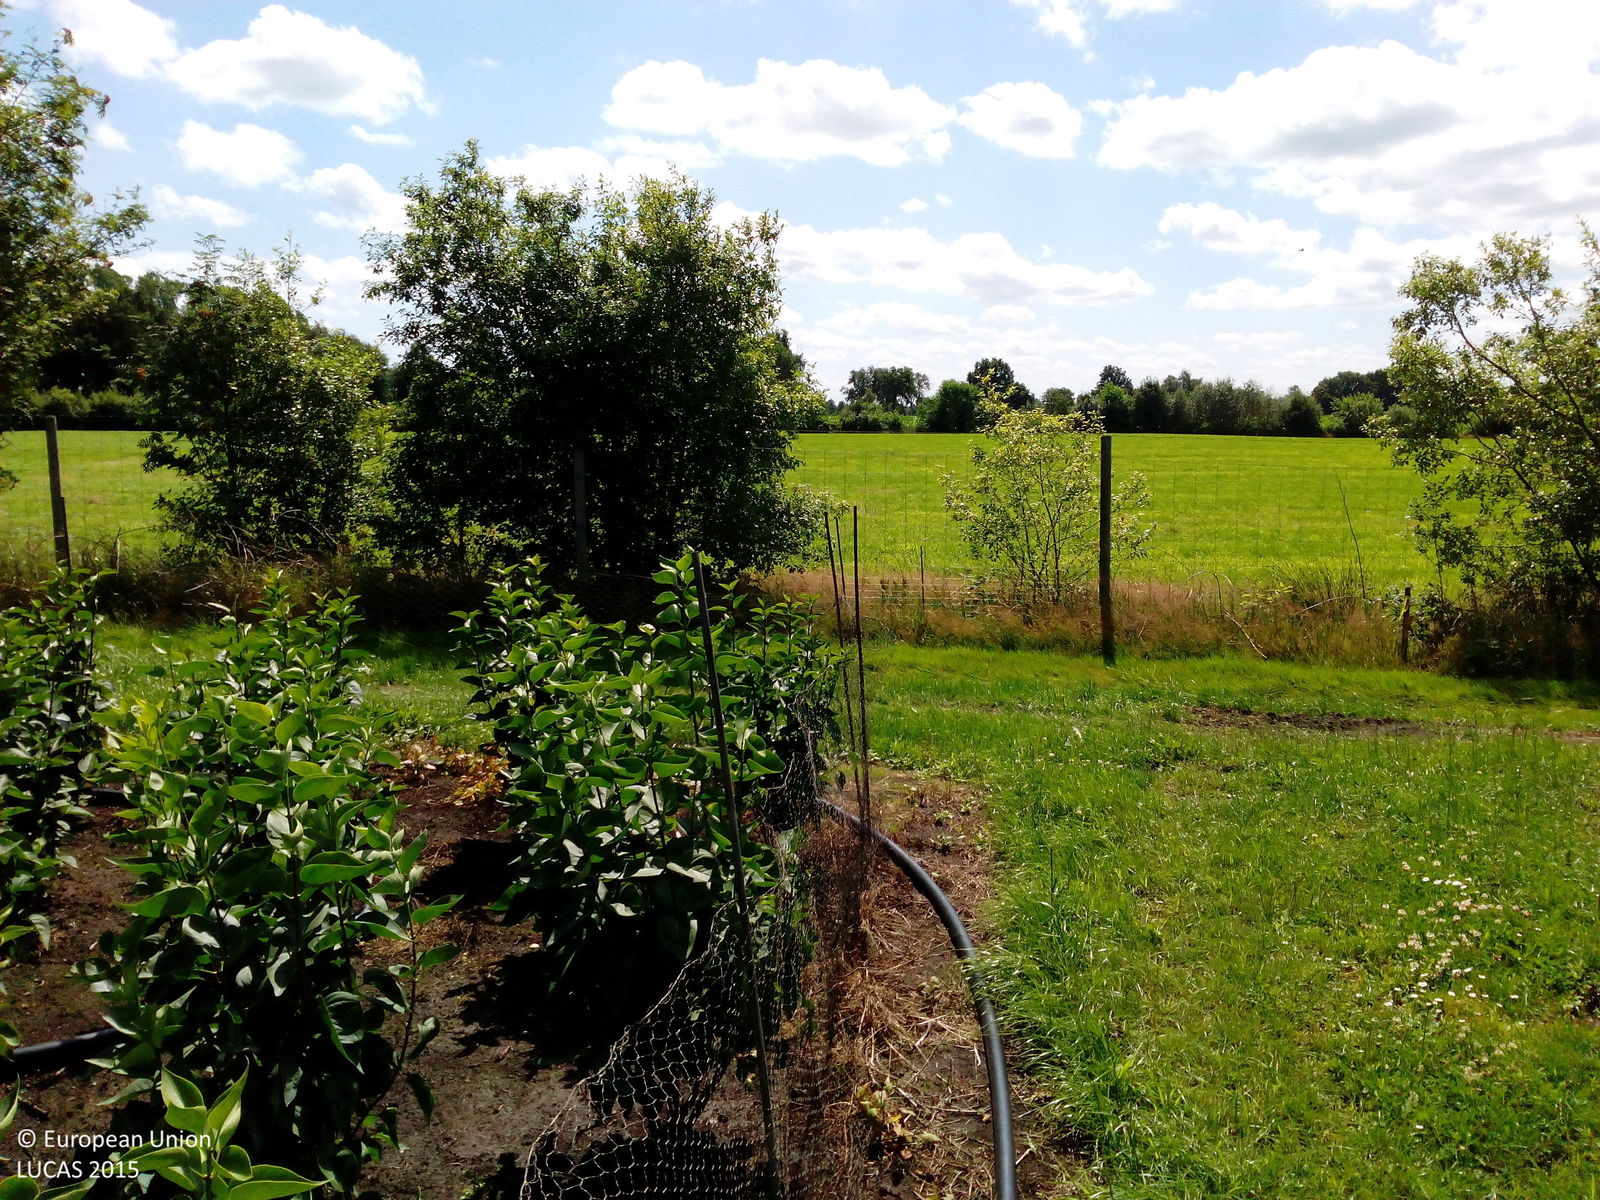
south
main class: Cropland
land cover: Nurseries
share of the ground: > 75 %
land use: Agriculture (excluding fallow land and kitchen gardens)
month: July
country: DE
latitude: 53.1684
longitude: 7.9213
